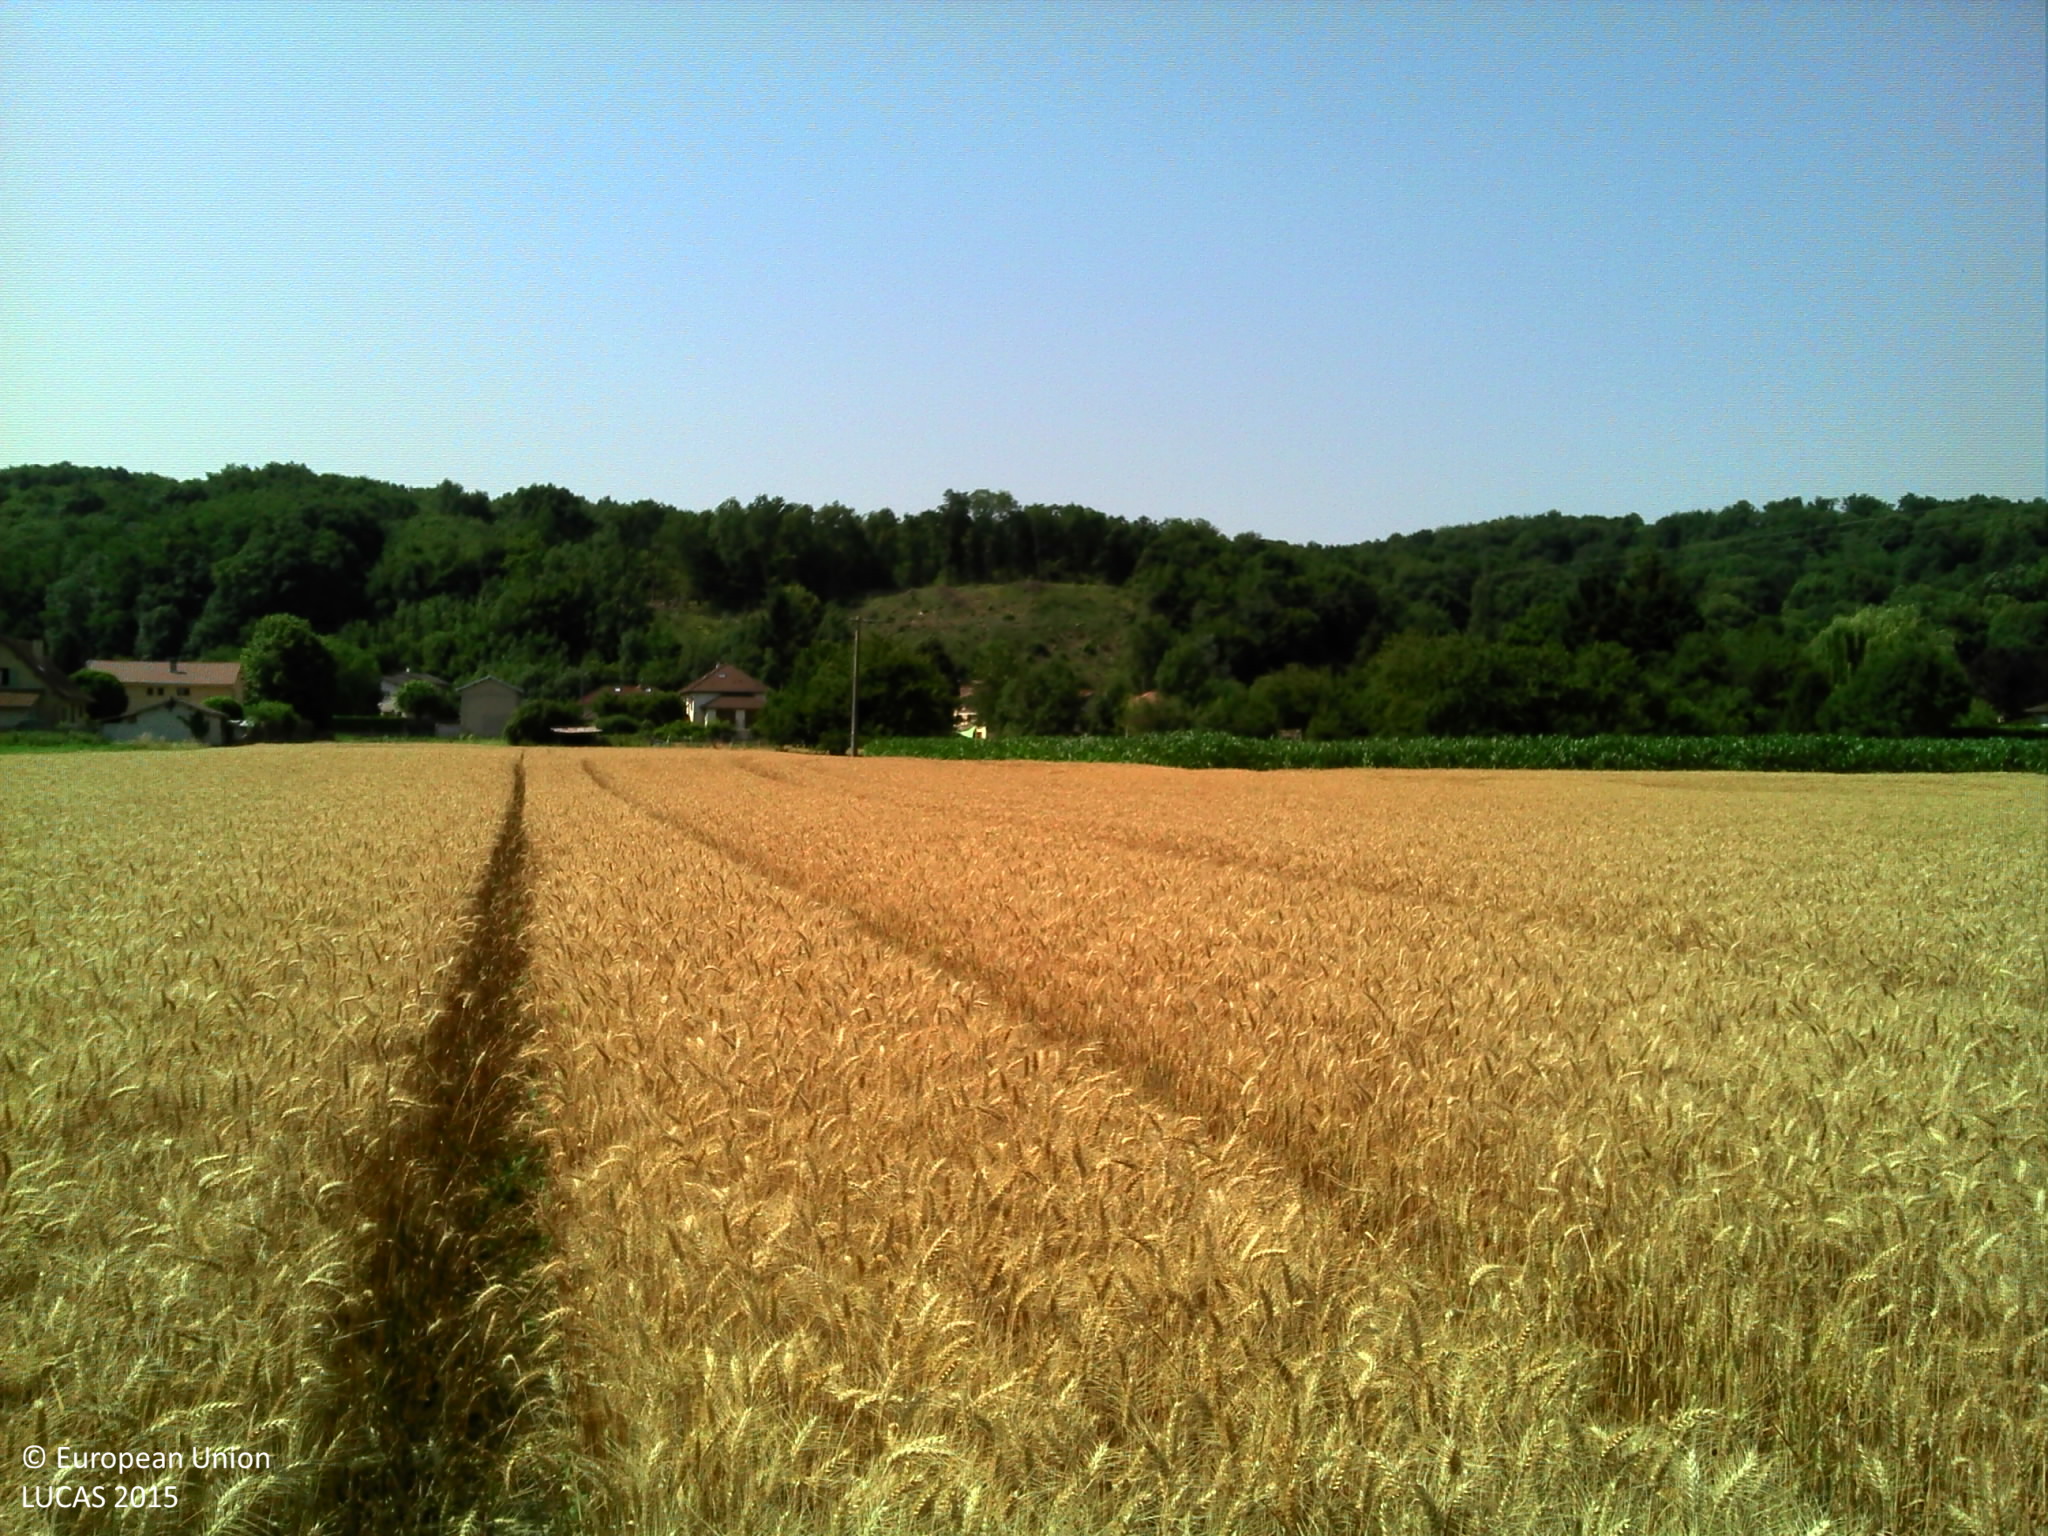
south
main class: Cropland
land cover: Durum wheat
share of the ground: > 75 %
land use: Agriculture (excluding fallow land and kitchen gardens)
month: July
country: FR
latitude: 45.6117
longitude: 5.1956
